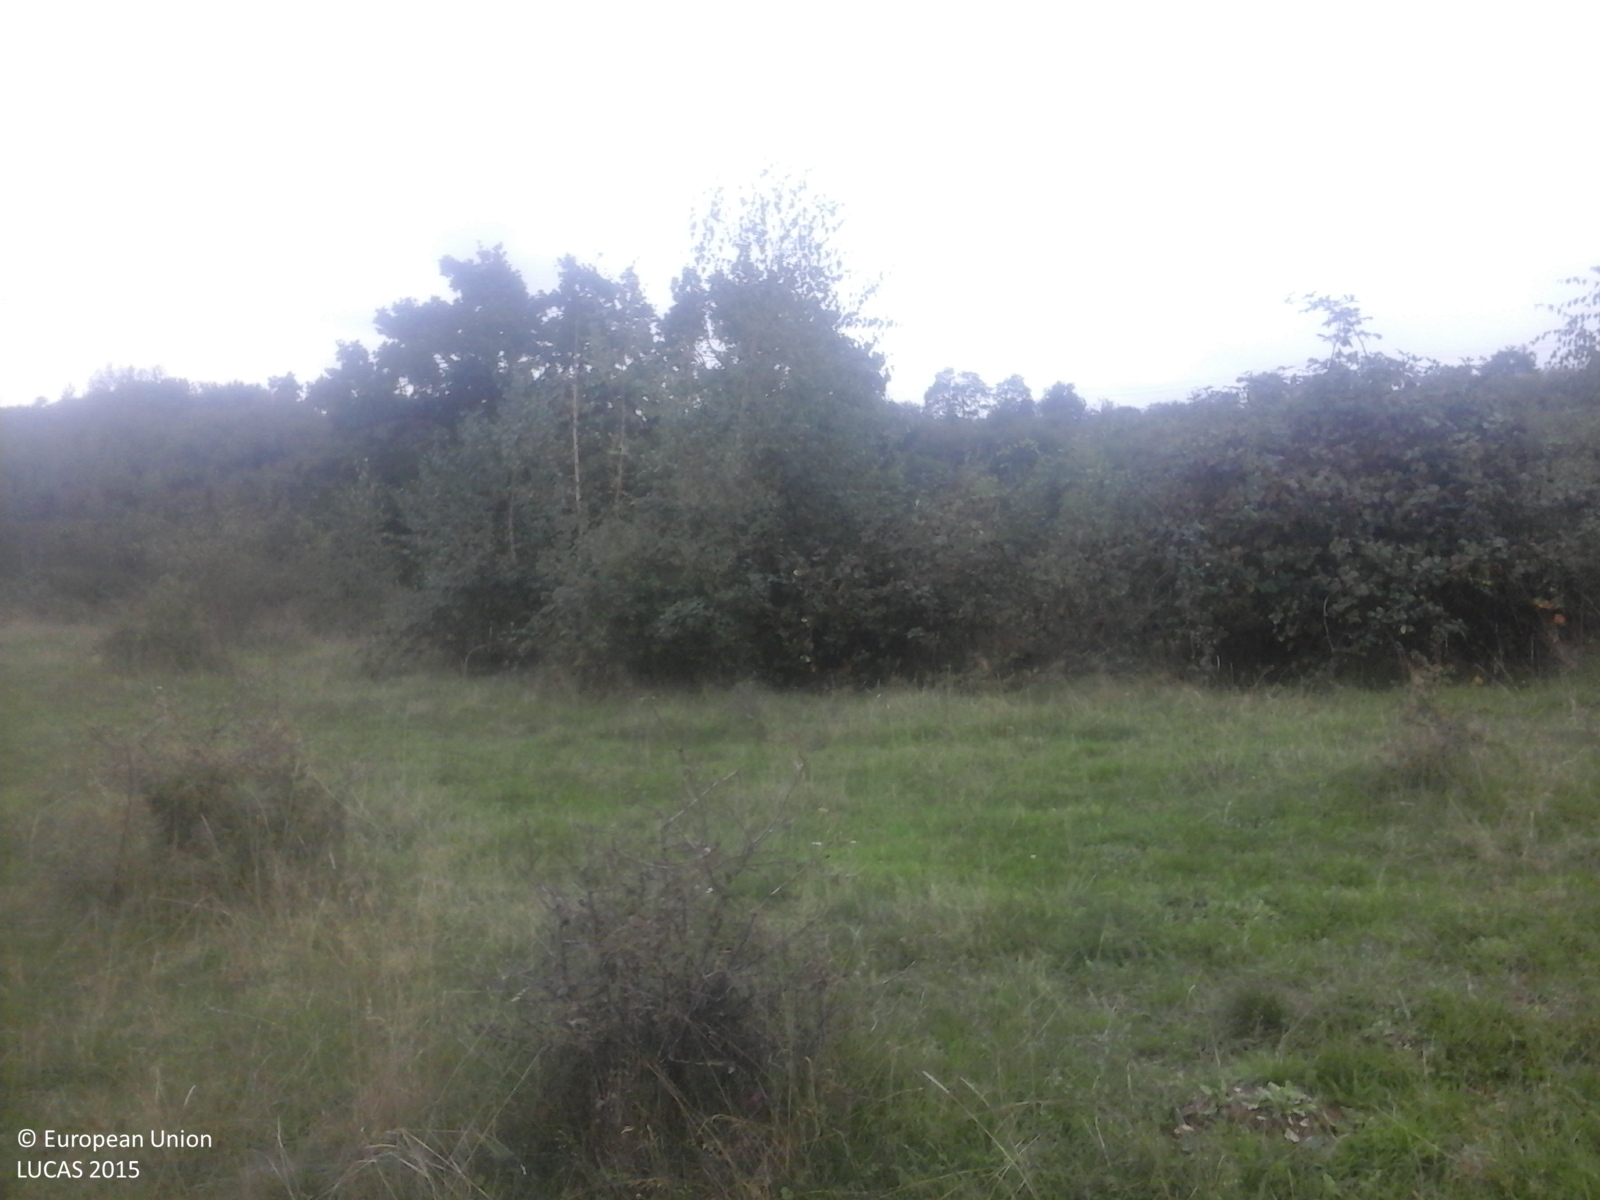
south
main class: Grassland
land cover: Grassland with sparse tree/shrub cover
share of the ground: > 75 %
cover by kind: herbaceous plants 85 %, shrubs 10 %, broadleaved forest trees 5 %
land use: Fallow land
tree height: < 5 m
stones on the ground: < 10 %
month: September
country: RO
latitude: 45.8067
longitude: 23.8769
